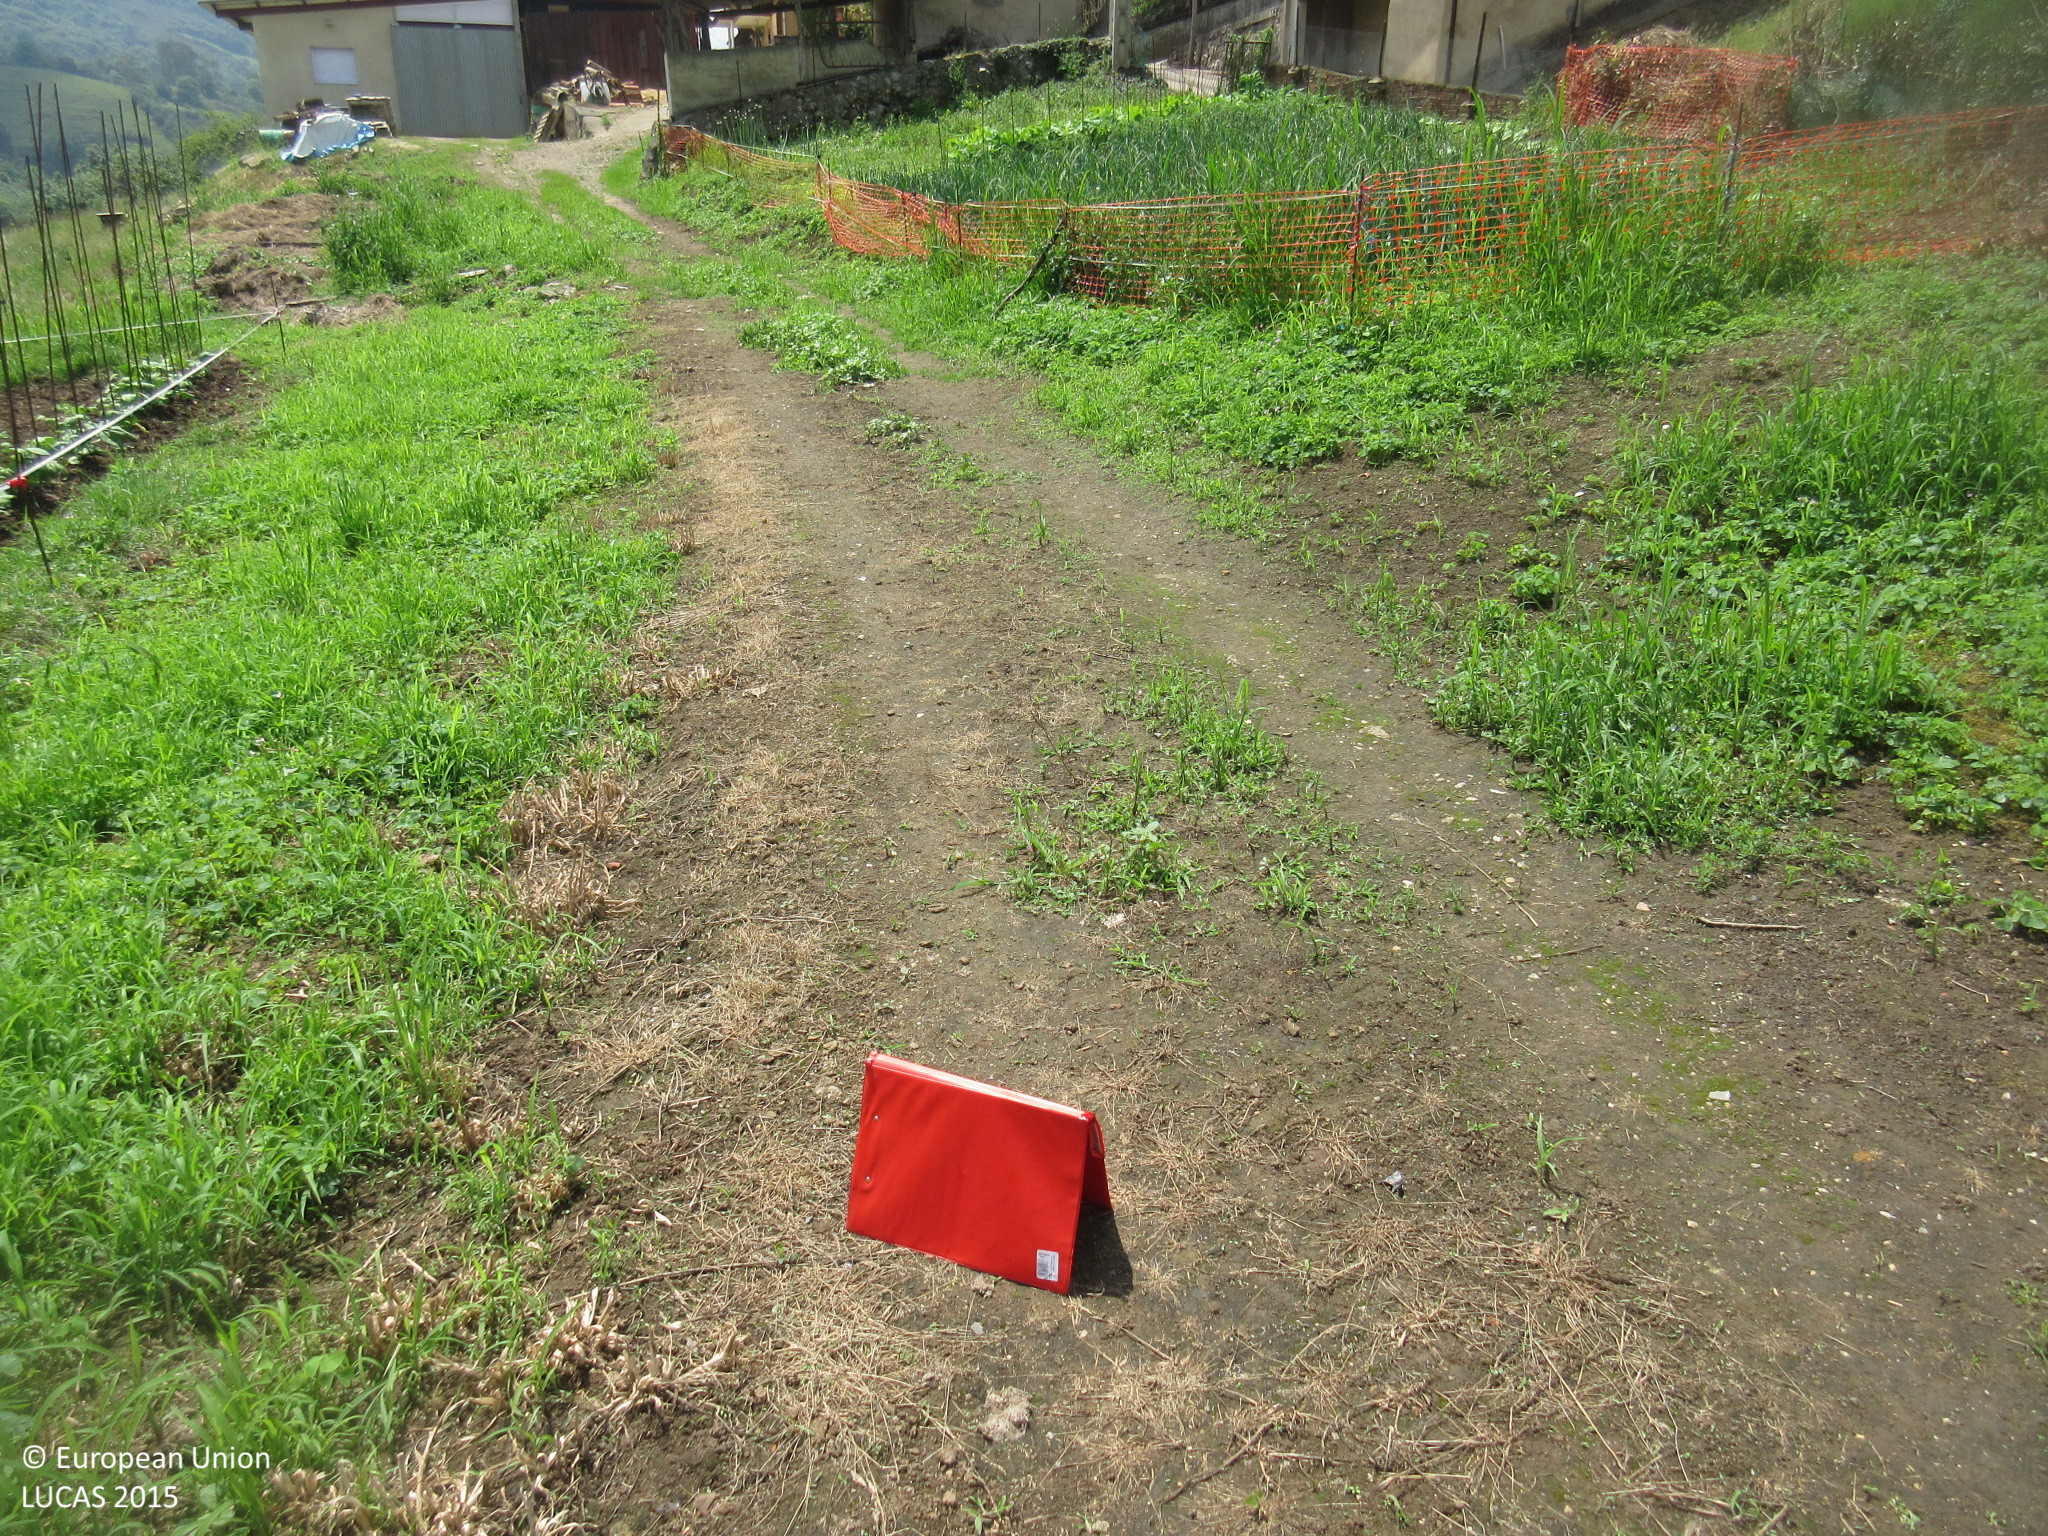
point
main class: Cropland
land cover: Dry pulses
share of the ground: 50 - 75 %
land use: Agriculture (excluding fallow land and kitchen gardens)
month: June
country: ES
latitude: 43.3533
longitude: -6.0194
